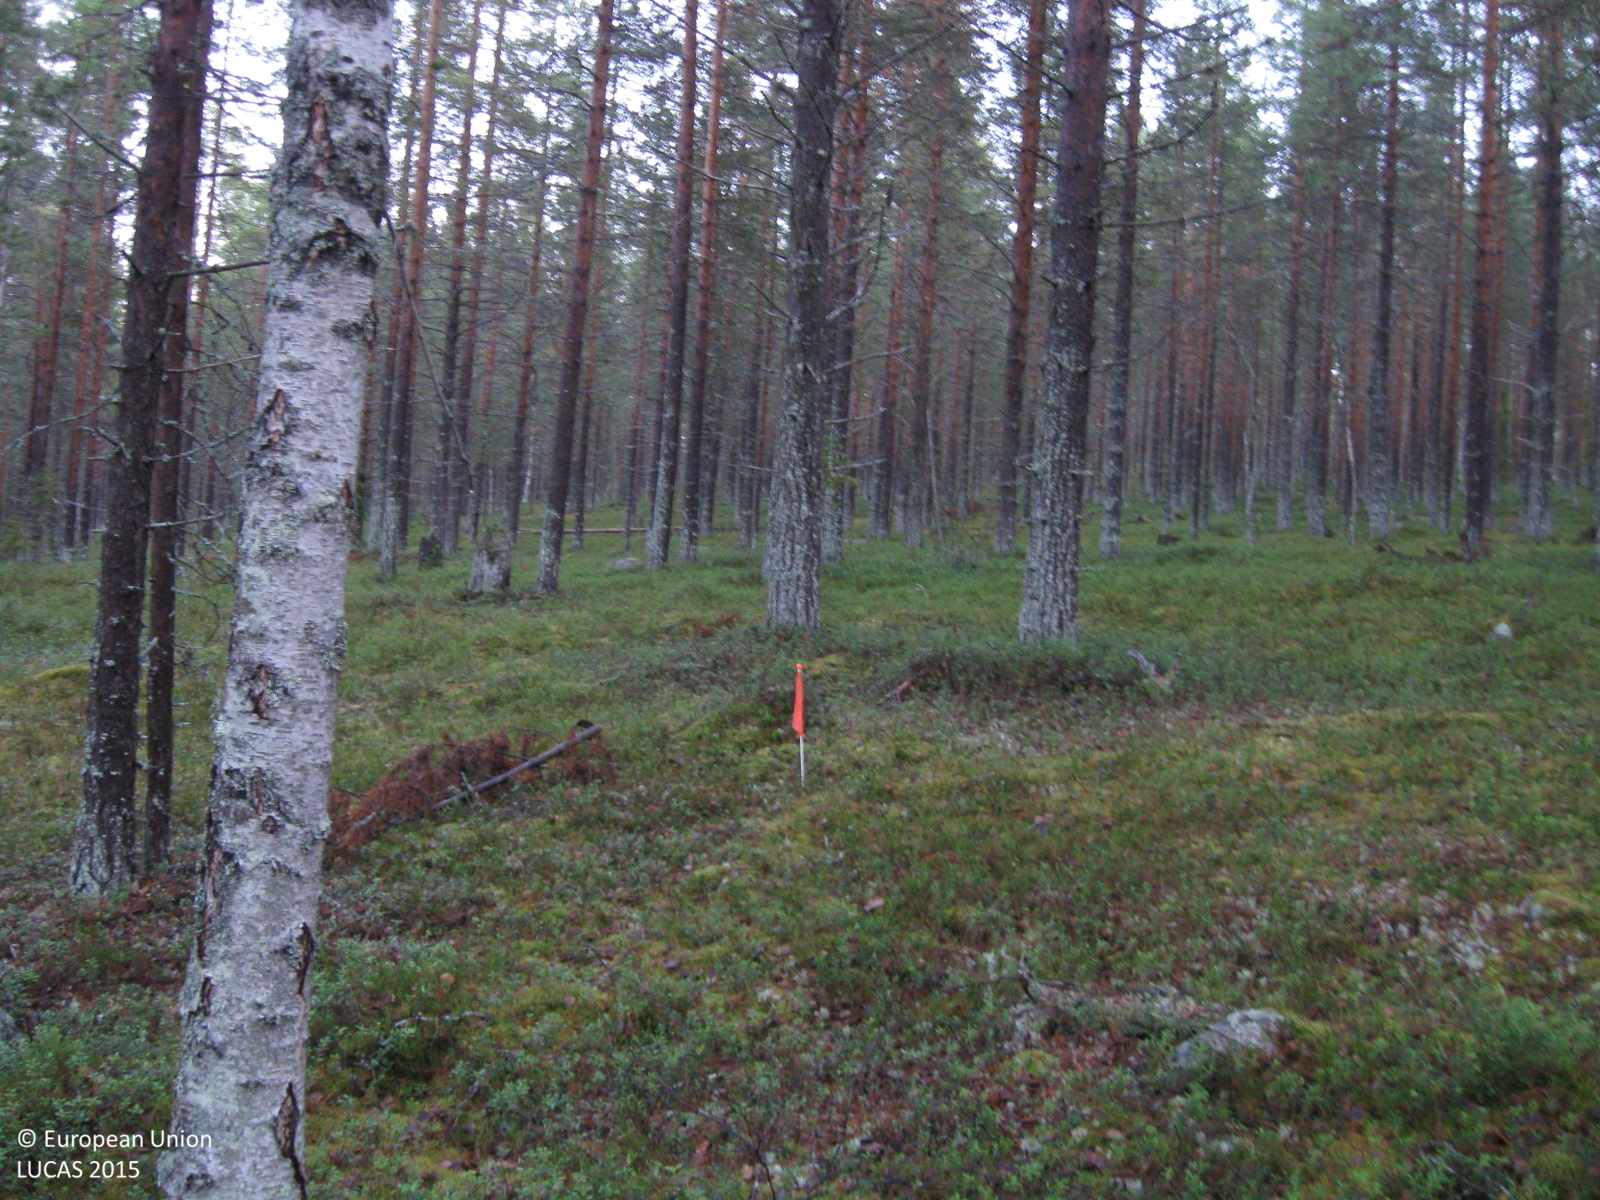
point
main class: Woodland
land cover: Pine dominated coniferous woodland
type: boreal forest
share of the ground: > 75 %
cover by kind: coniferous forest trees 75 %, shrubs 10 %, lichens and mosses 10 %, herbaceous plants 5 %
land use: Forestry
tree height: > 5 m
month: October
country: SE
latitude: 66.4548
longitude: 20.8838
